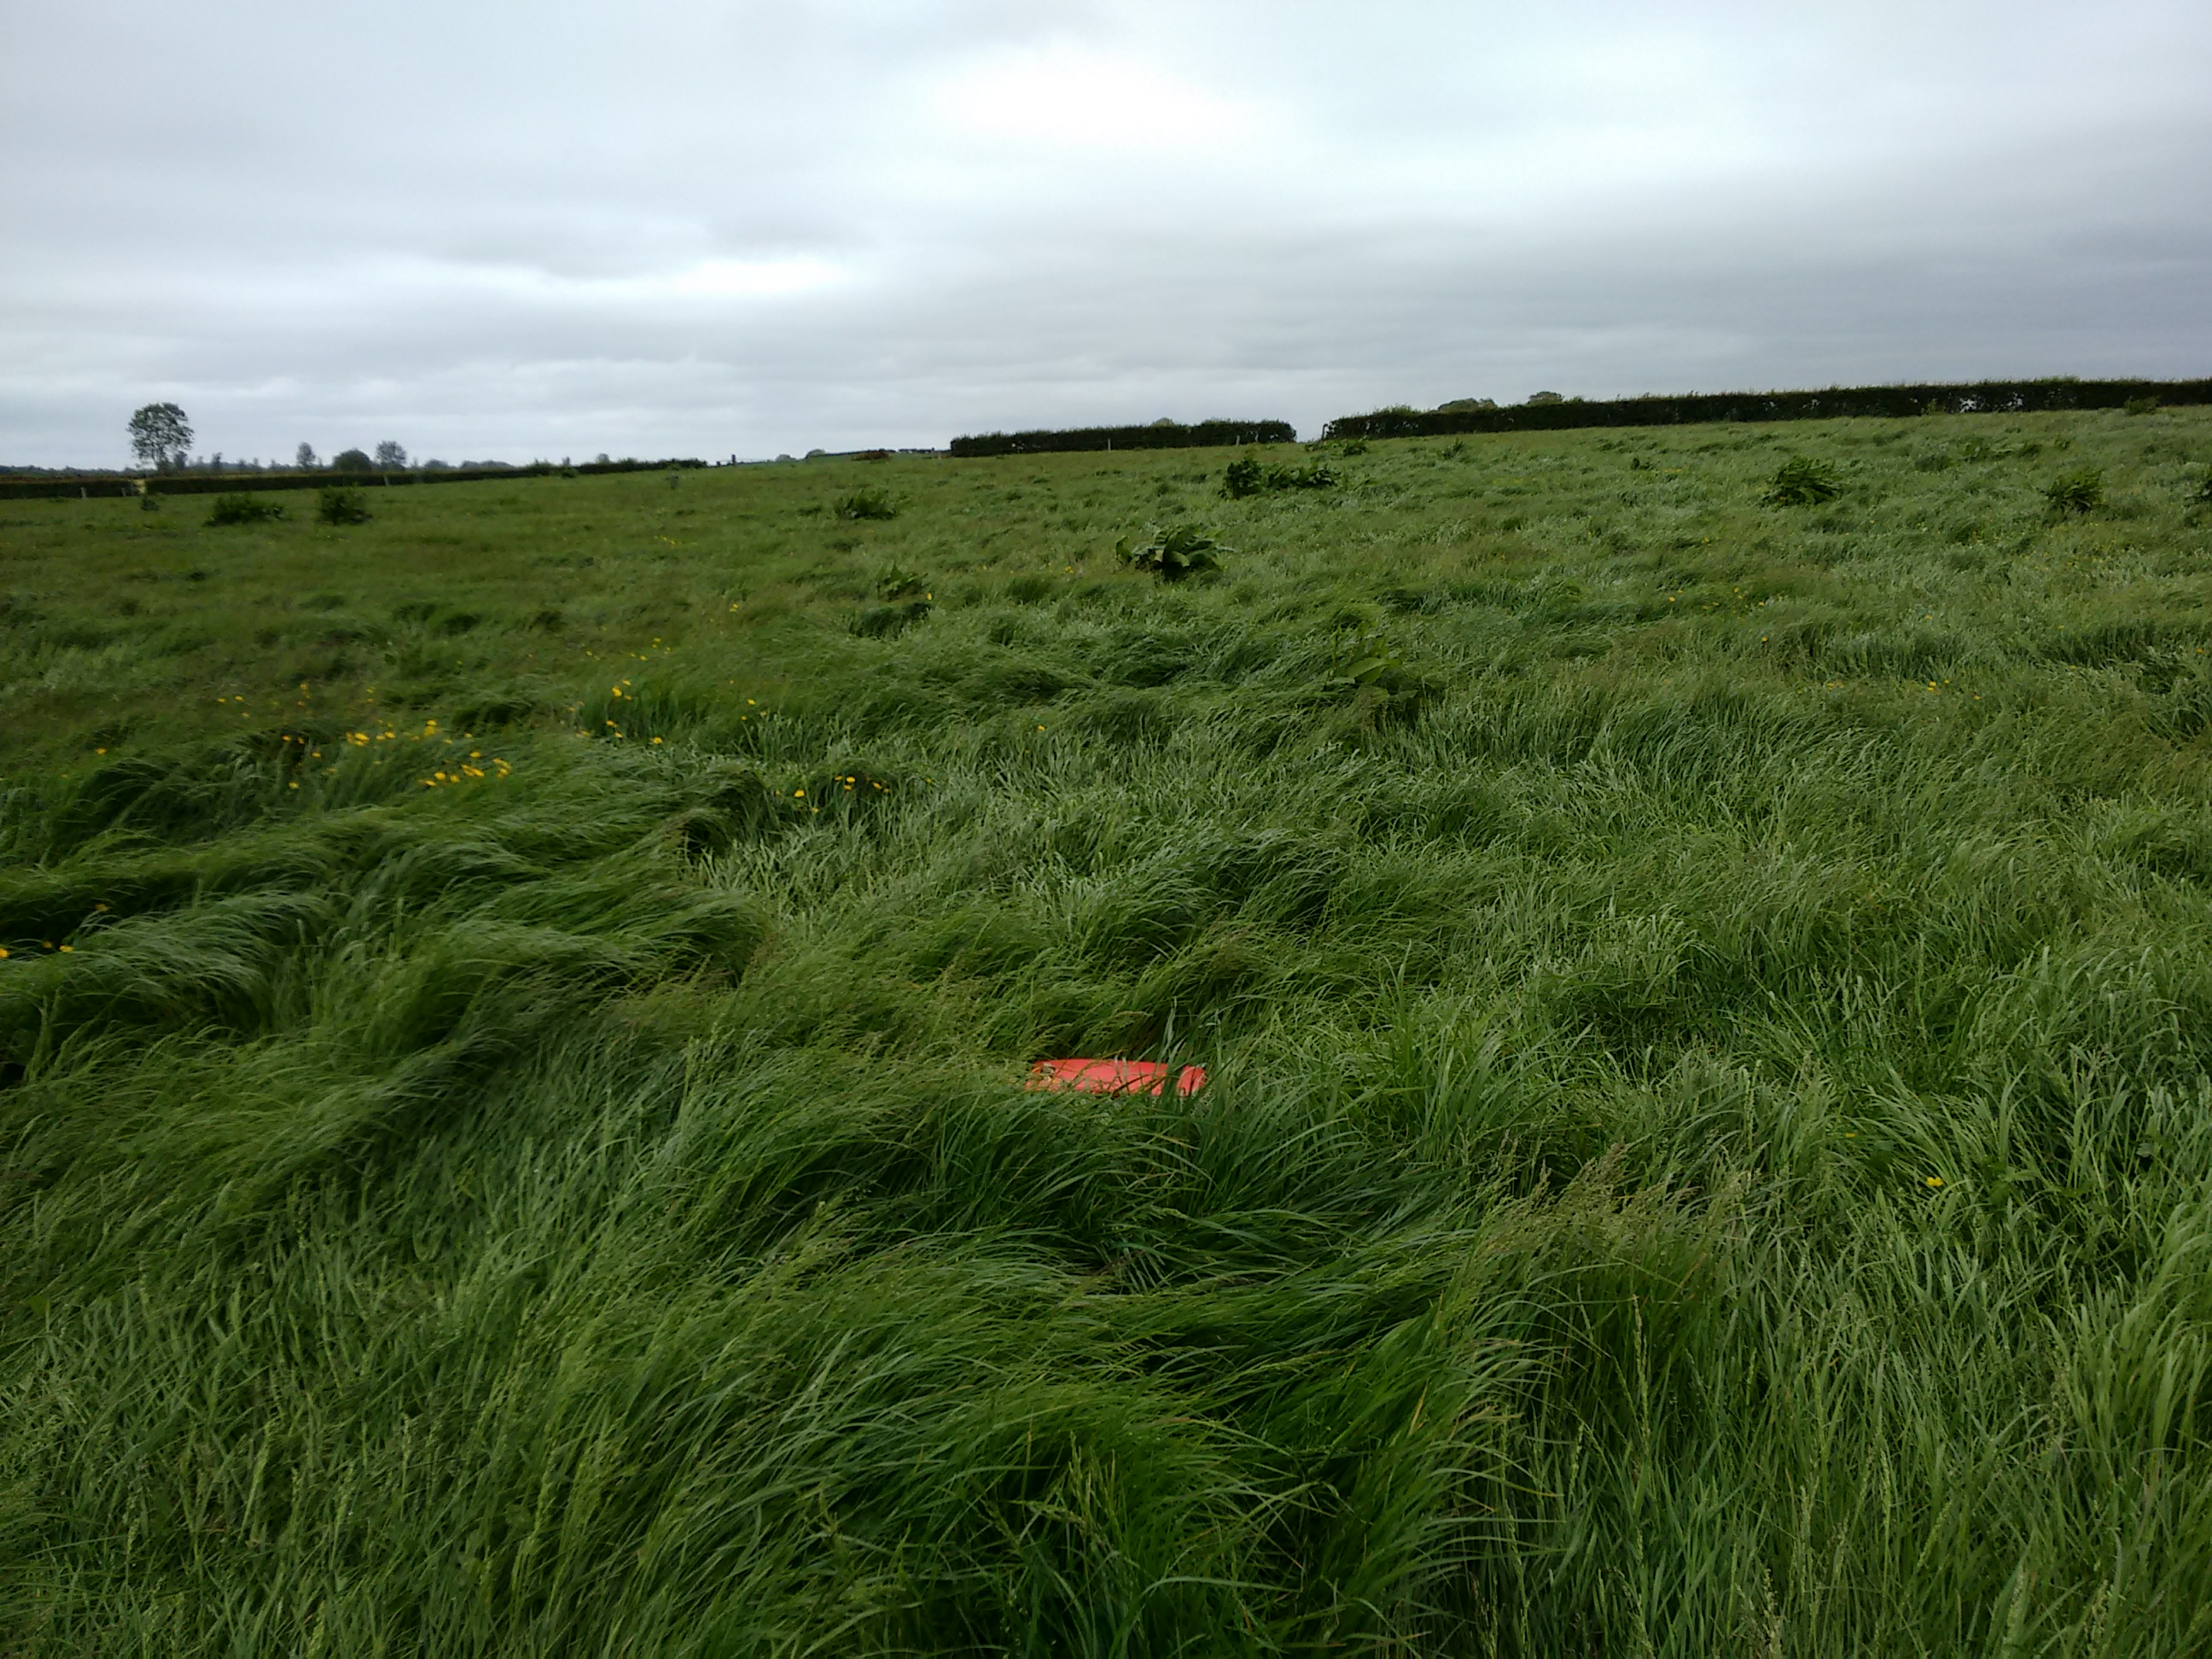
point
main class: Grassland
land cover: Grassland without tree/shrub cover
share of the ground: > 75 %
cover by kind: herbaceous plants 100 %
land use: Agriculture (excluding fallow land and kitchen gardens)
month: June
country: GB
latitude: 55.0177
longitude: -6.6264
